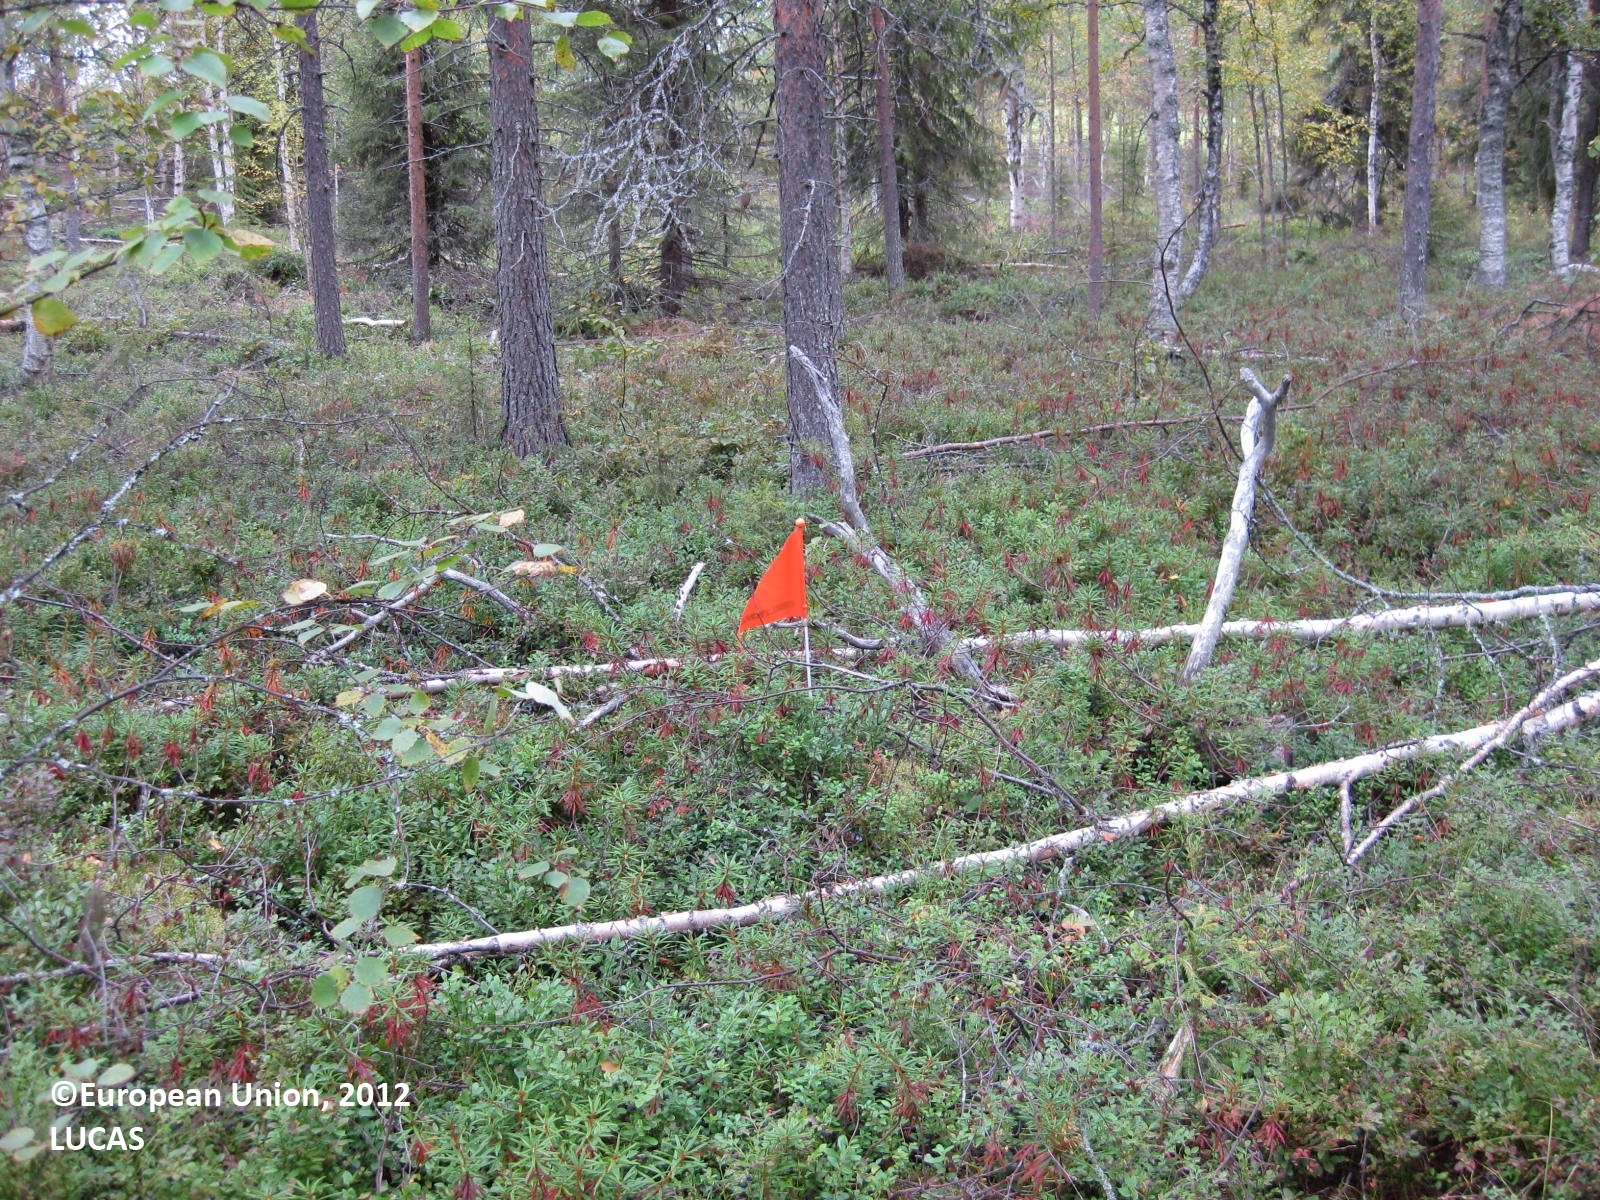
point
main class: Woodland
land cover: Pine dominated mixed woodland
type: boreal forest
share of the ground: 25 - 50 %
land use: Forestry
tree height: > 5 m
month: August
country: FI
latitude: 65.9680
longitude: 29.6269
